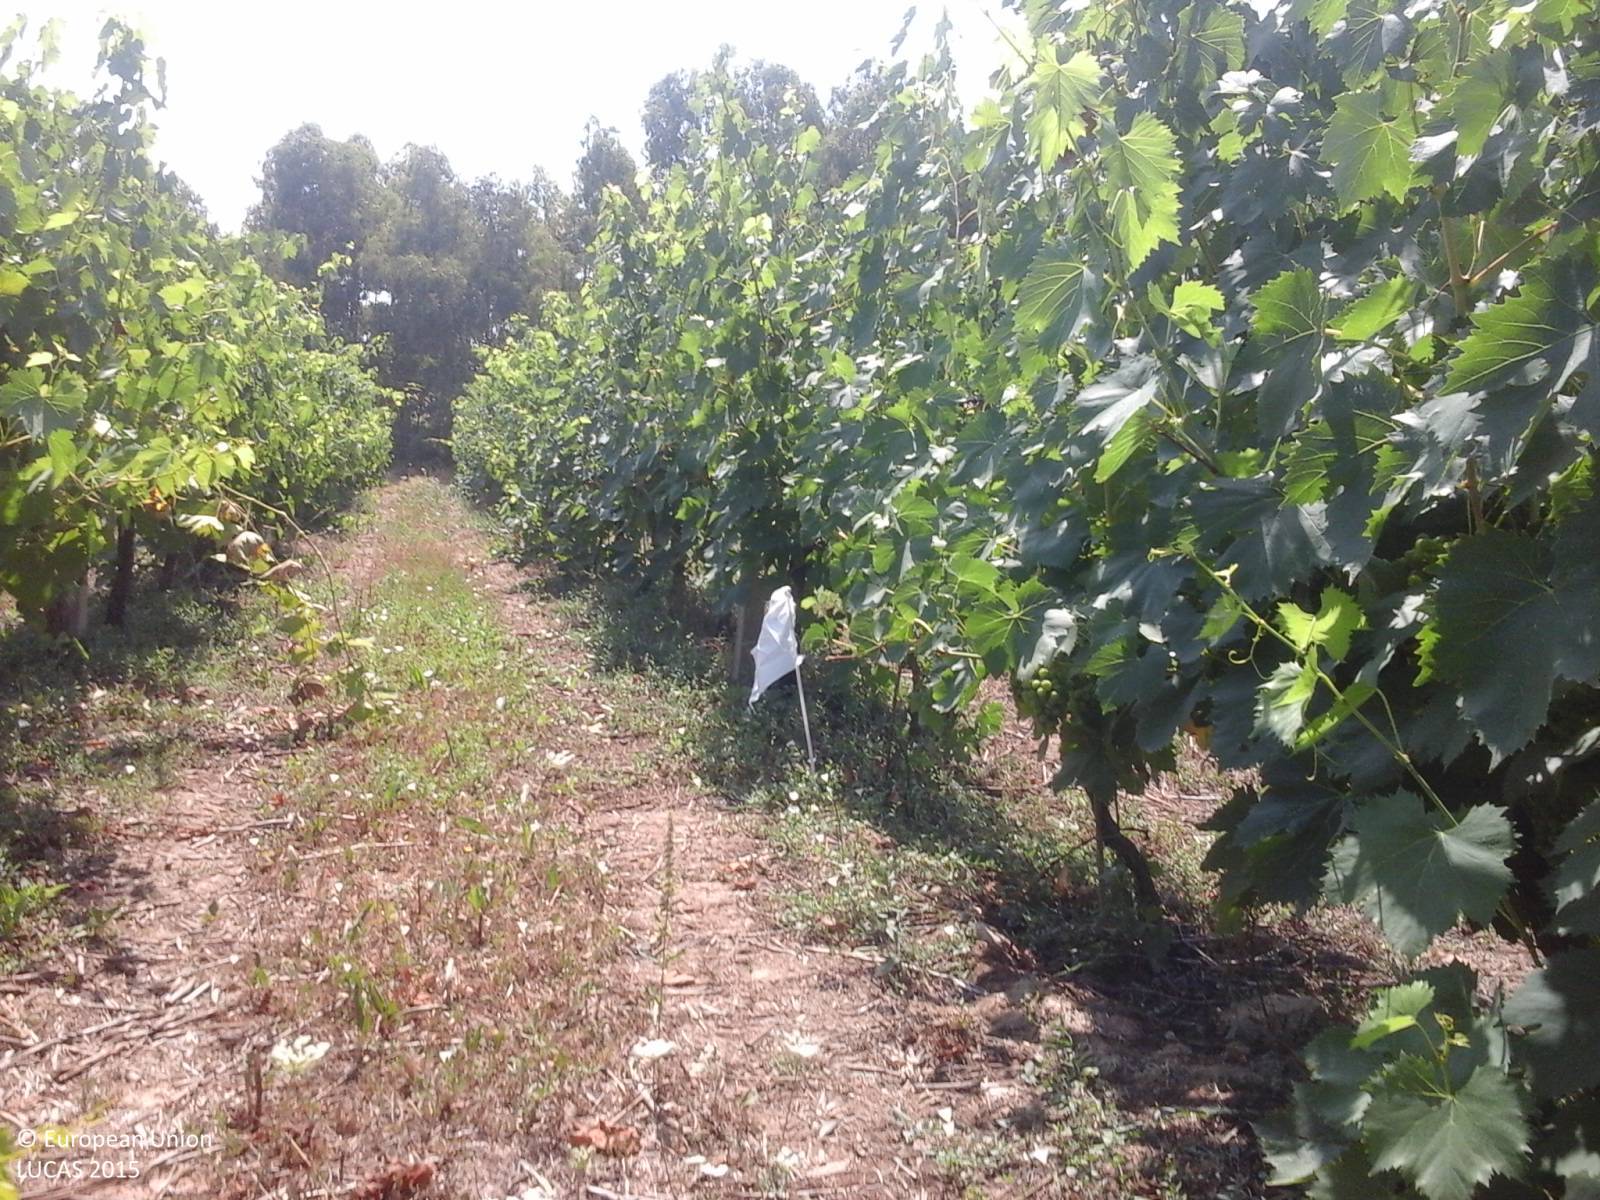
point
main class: Cropland
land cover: Vineyards
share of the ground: 25 - 50 %
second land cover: Spontaneously vegetated surfaces
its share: 50 - 75 %
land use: Agriculture (excluding fallow land and kitchen gardens)
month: July
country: IT
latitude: 39.2974
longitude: 8.6055
